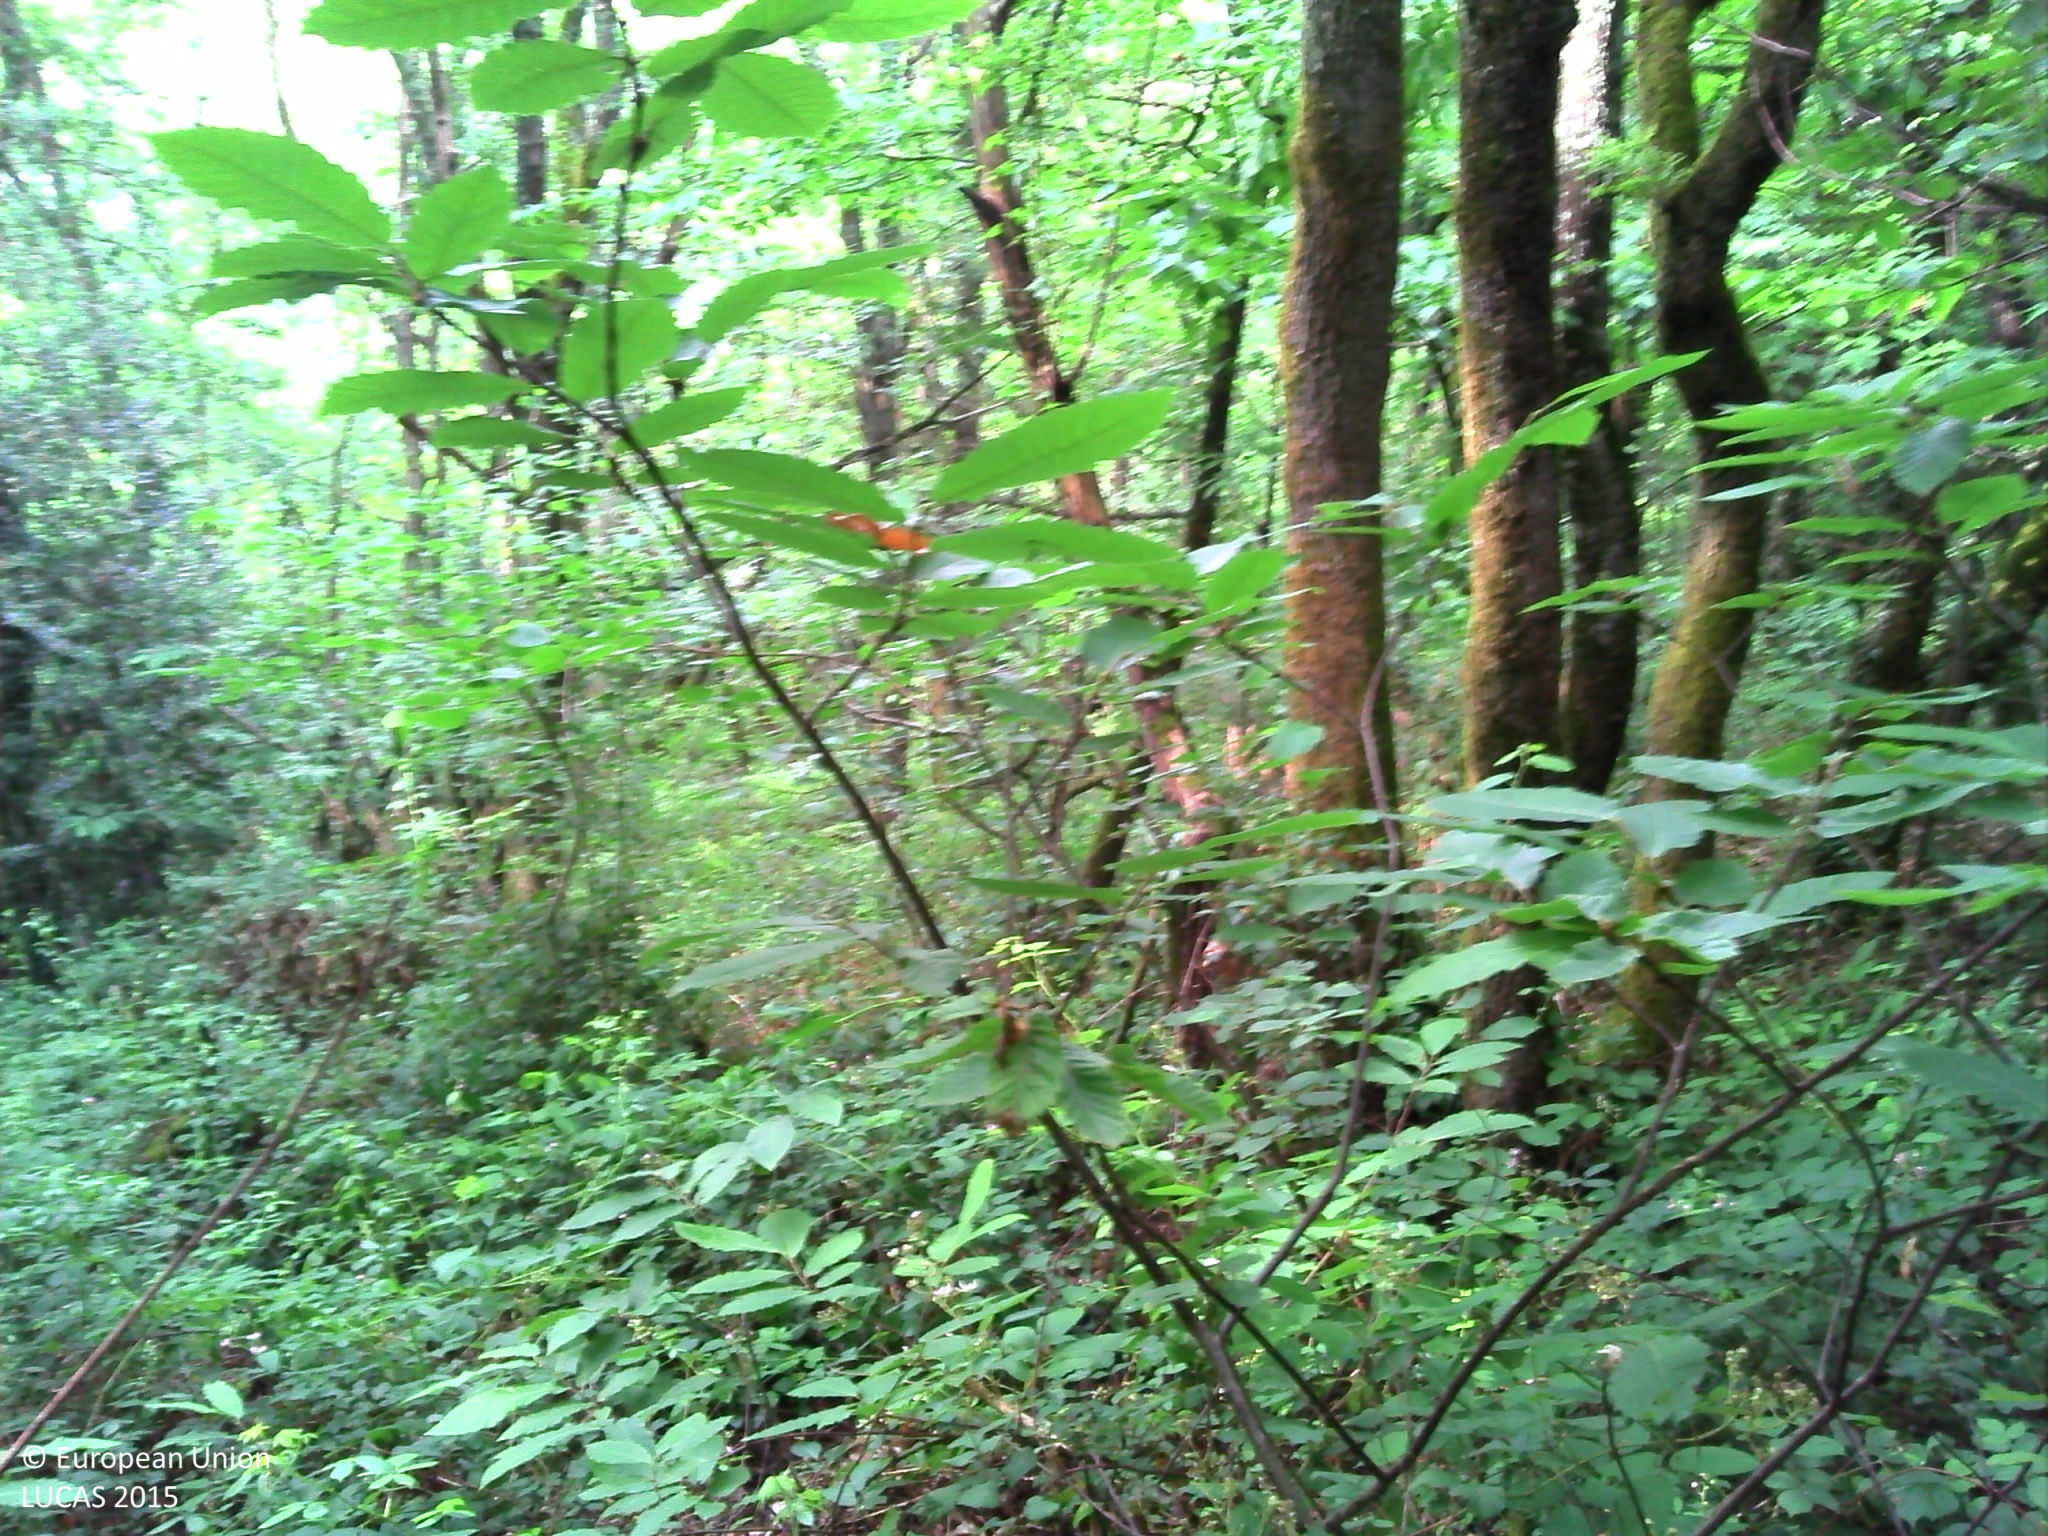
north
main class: Woodland
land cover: Broadleaved woodland
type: acidophilous oak and oak-birch forest
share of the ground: > 75 %
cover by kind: broadleaved forest trees 90 %, shrubs 5 %, herbaceous plants 5 %
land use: Forestry
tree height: > 5 m
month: June
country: FR
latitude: 43.6457
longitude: -0.2109
